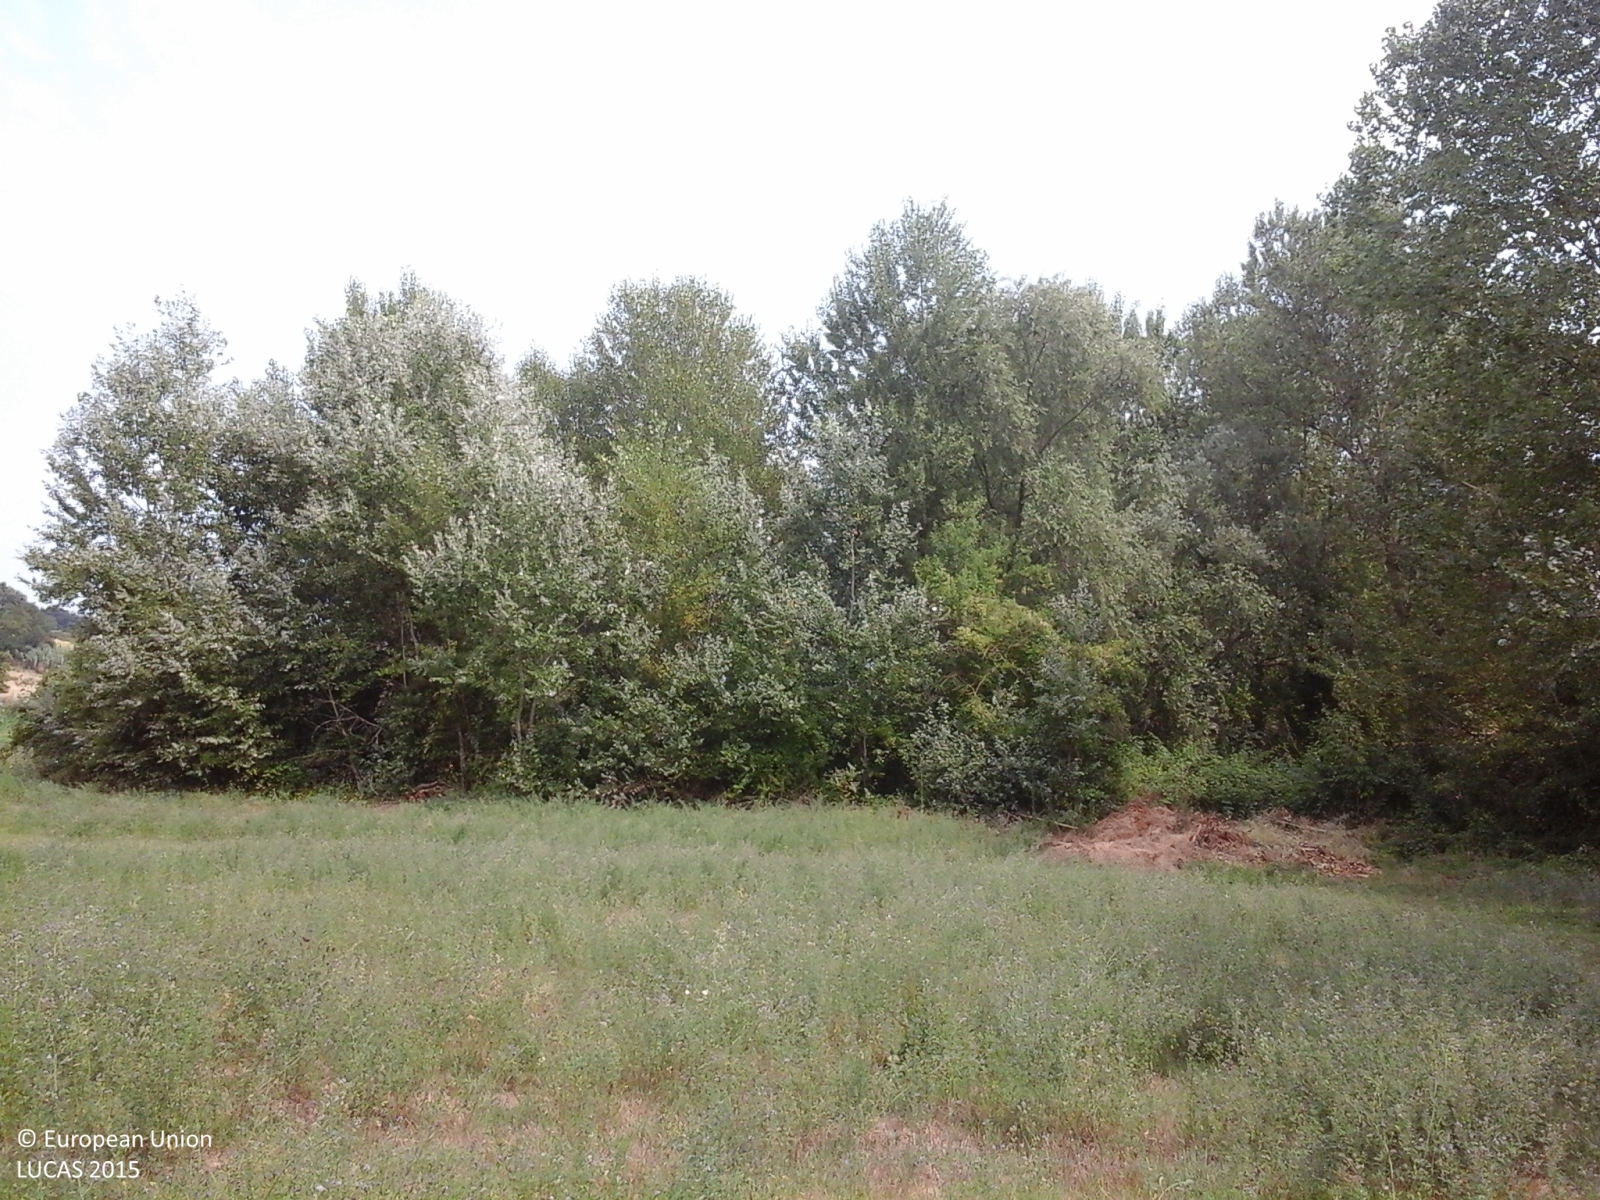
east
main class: Cropland
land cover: Lucerne
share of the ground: > 75 %
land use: Agriculture (excluding fallow land and kitchen gardens)
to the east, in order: Lucerne; Broadleaved woodland; Inland fresh water bodies; Broadleaved woodland; Spontaneously vegetated surfaces; Maize; Grassland without tree/shrub cover; Single bushes/trees; Fences; Grassland with sparse tree/shrub cover; Lucerne
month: August
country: IT
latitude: 43.4982
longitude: 13.4667
